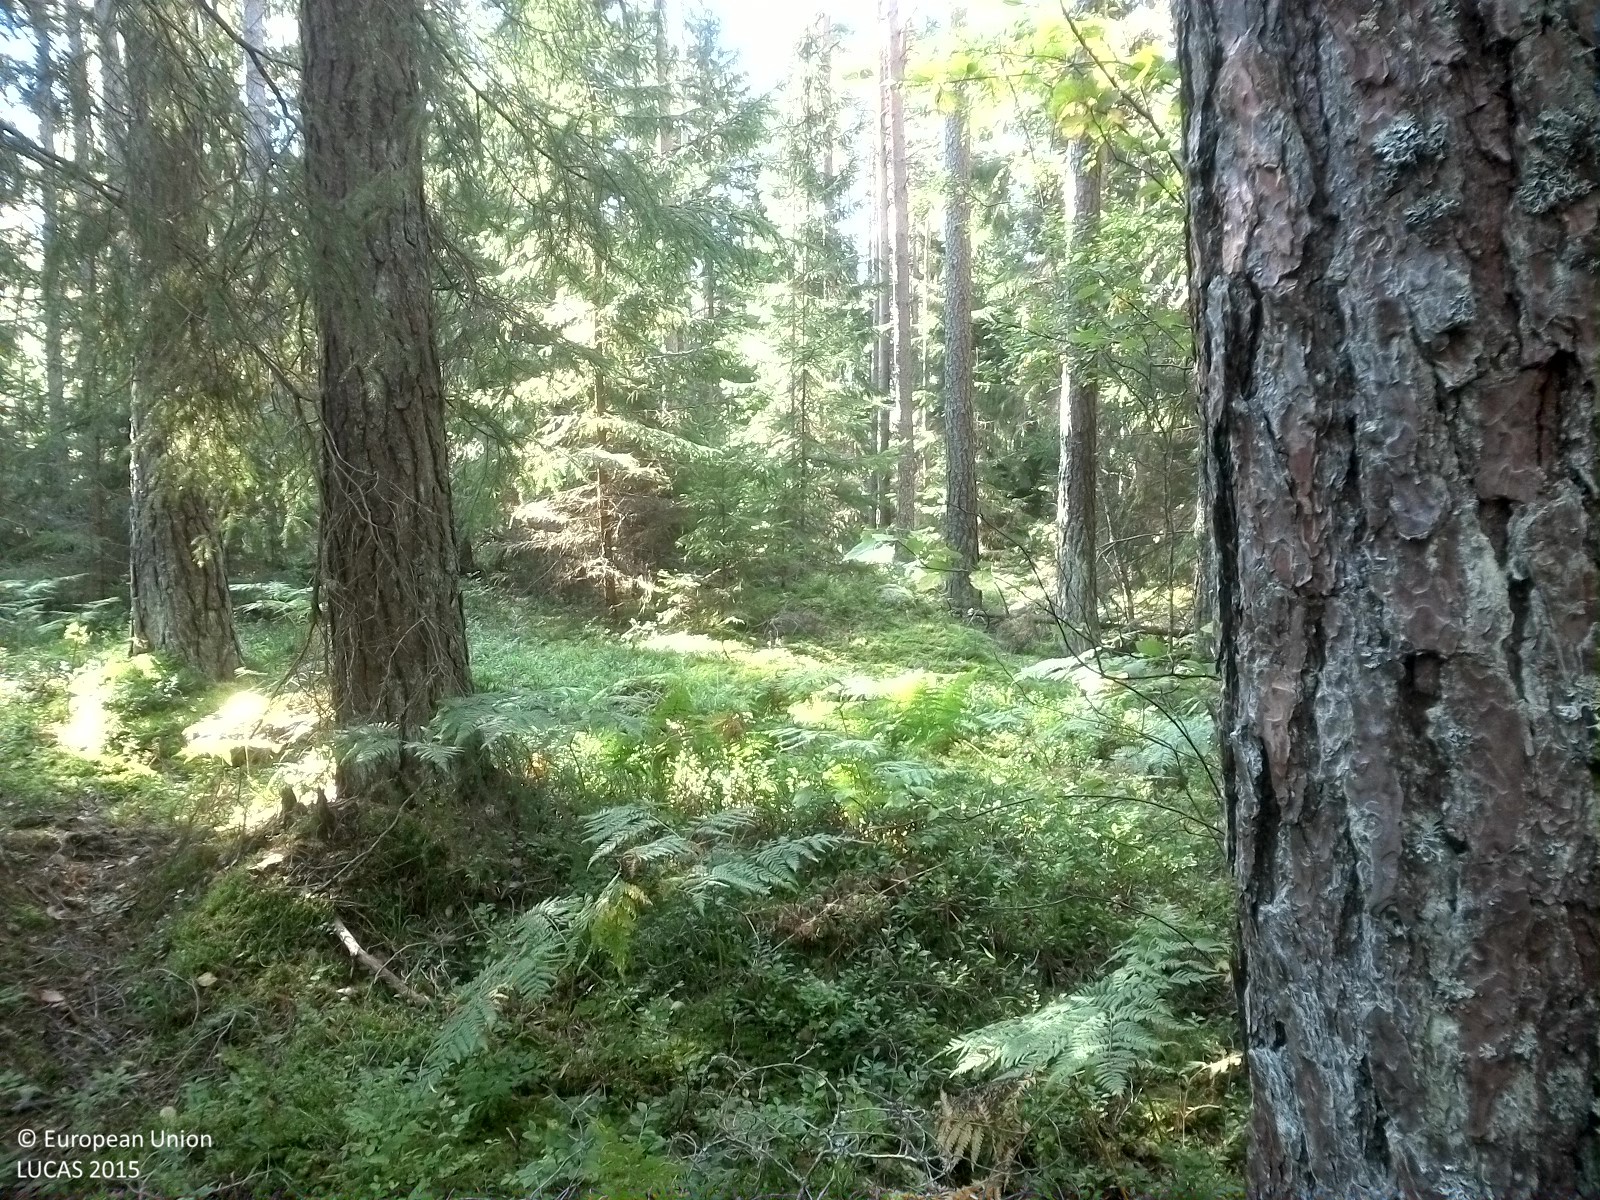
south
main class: Woodland
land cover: Pine dominated coniferous woodland
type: boreal forest
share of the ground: 25 - 50 %
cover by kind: coniferous forest trees 40 %, herbaceous plants 40 %, lichens and mosses 15 %, broadleaved forest trees 5 %
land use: Forestry
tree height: > 5 m
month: September
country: SE
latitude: 59.1194
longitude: 15.8795
